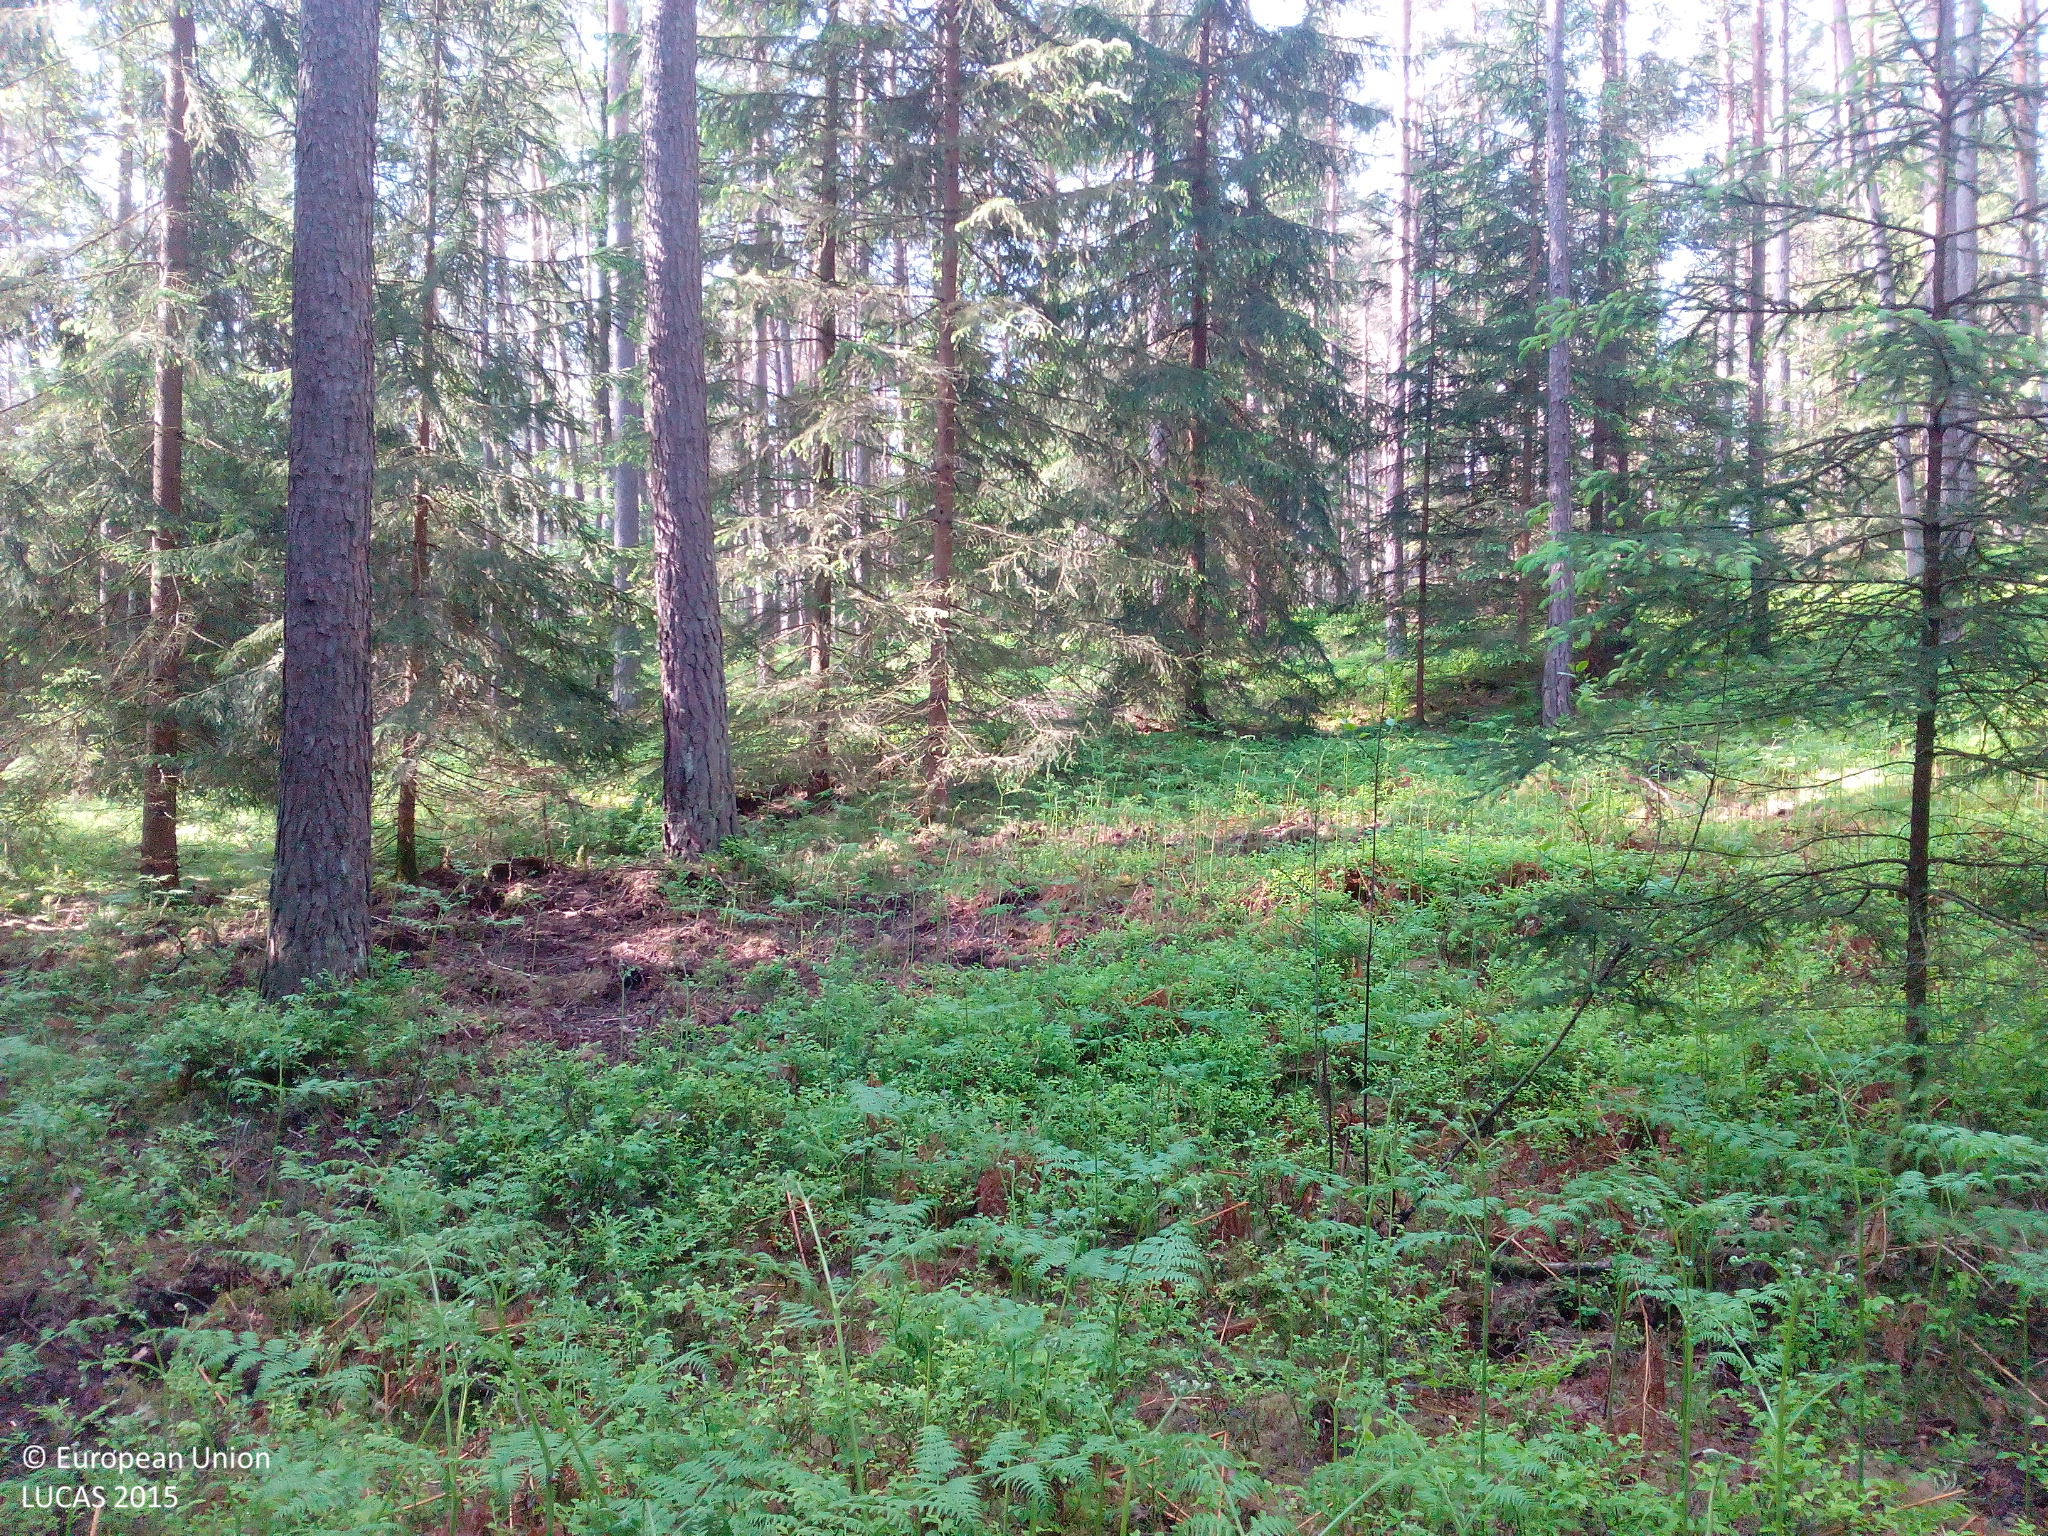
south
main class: Woodland
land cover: Other coniferous woodland
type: hemiboreal forest and nemoral coniferous forest and mixed broadleaved-coniferous forest
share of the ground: > 75 %
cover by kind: coniferous forest trees 80 %, shrubs 10 %, herbaceous plants 10 %
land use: Forestry
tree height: > 5 m
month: May
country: DE
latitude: 49.8324
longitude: 11.5150
